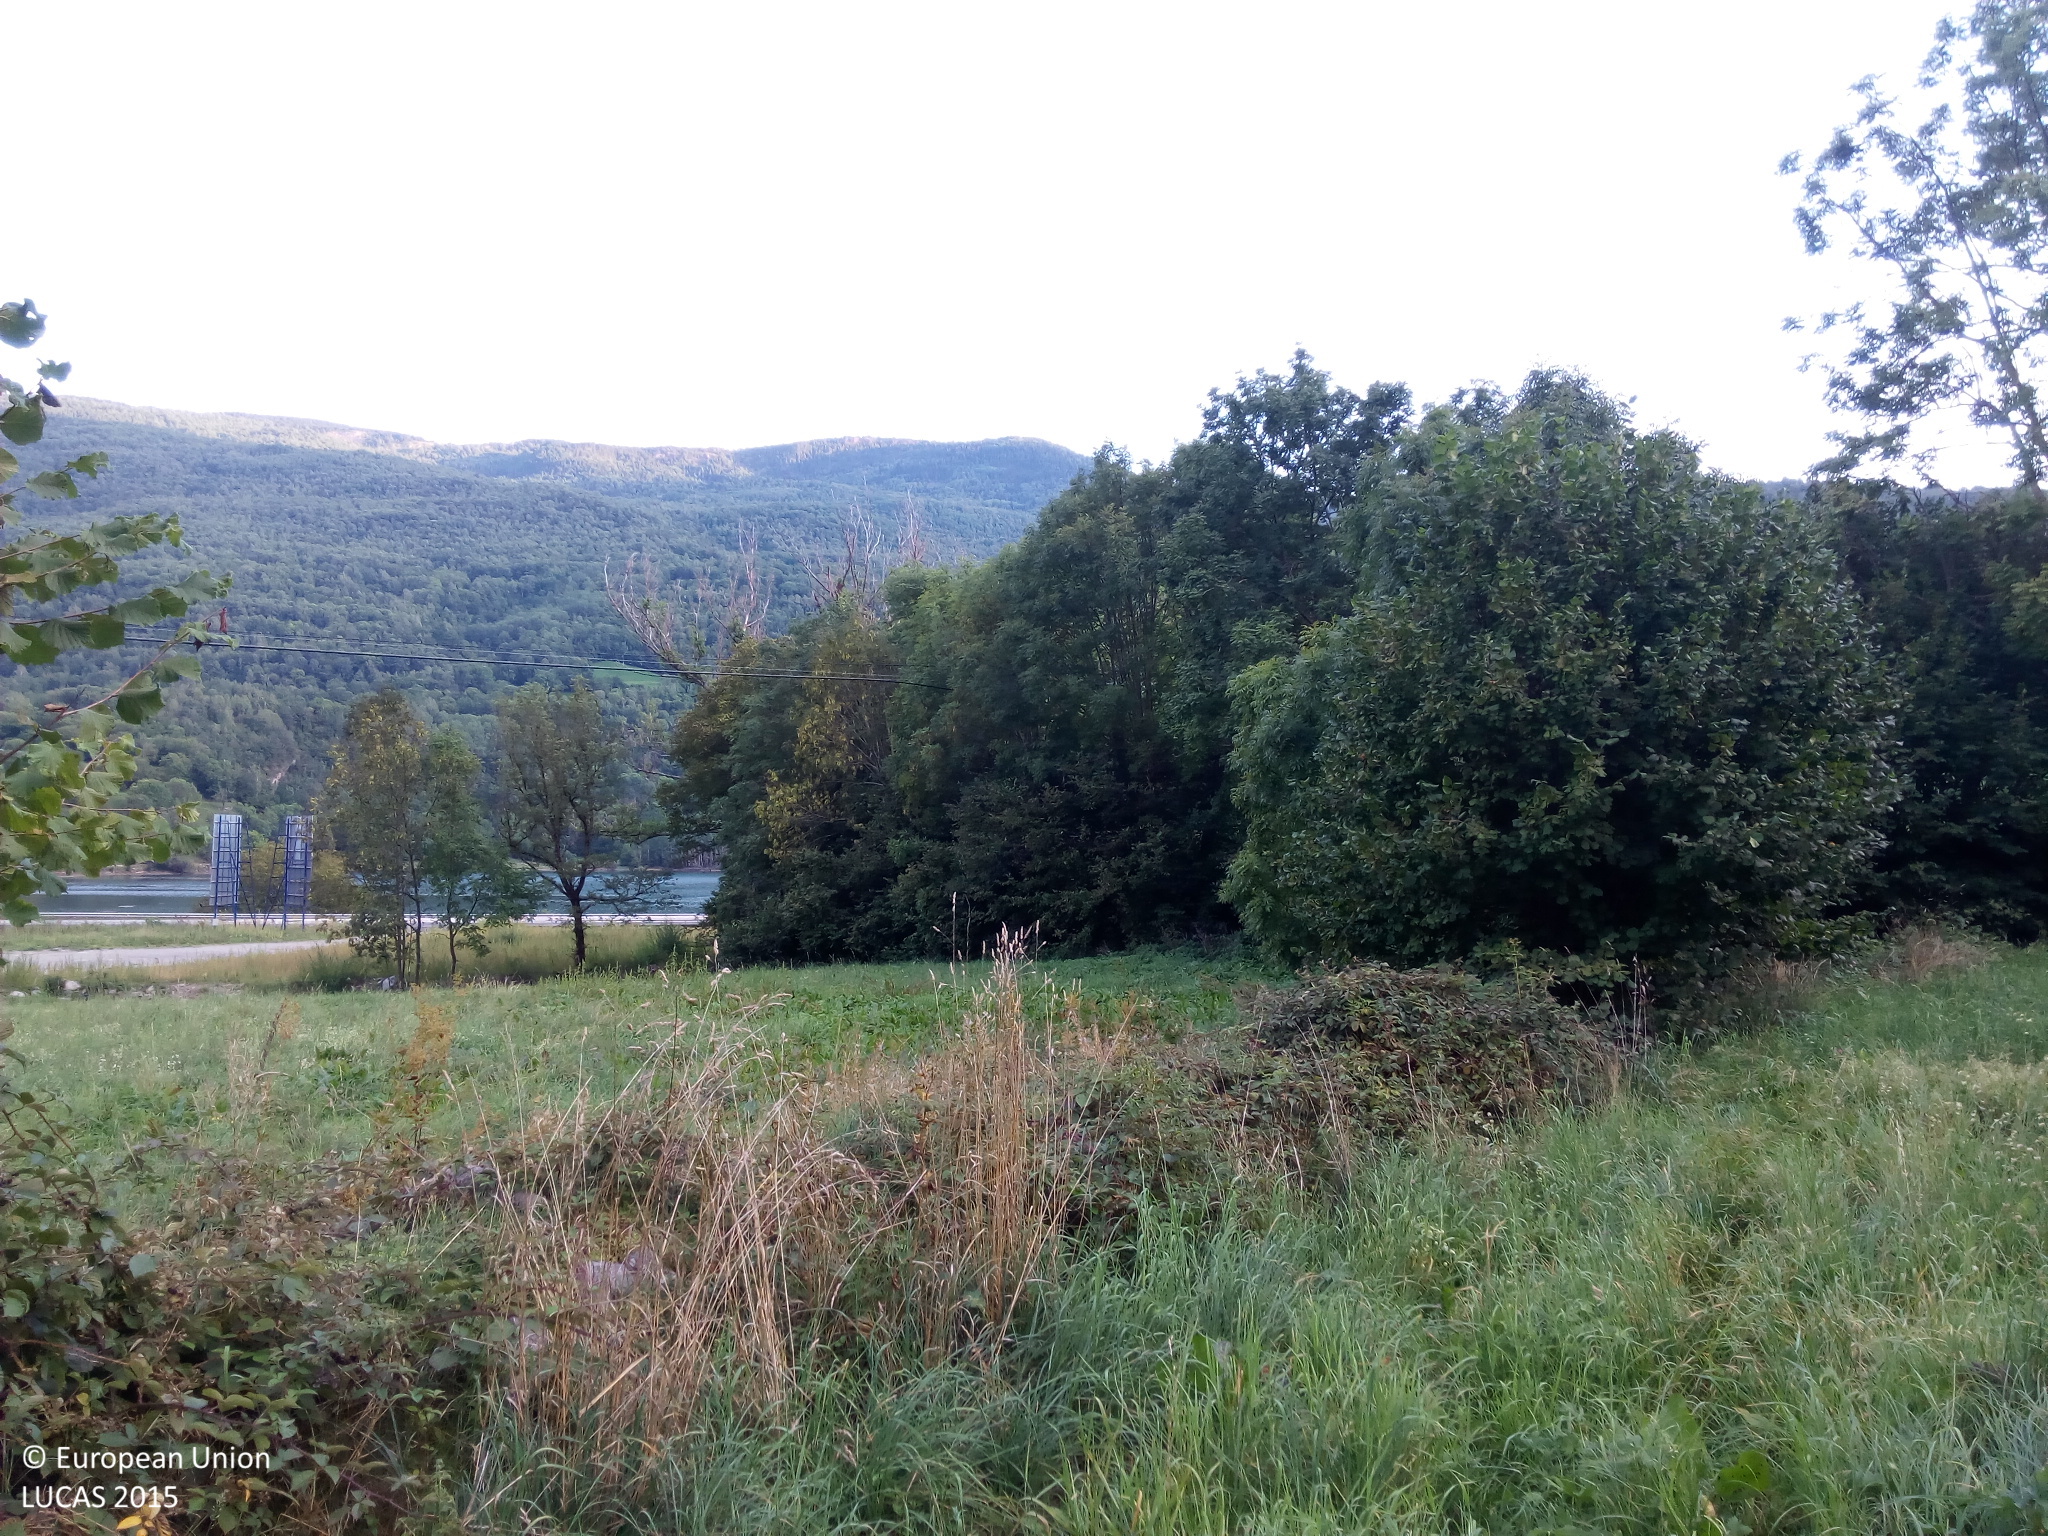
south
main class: Cropland
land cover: Apple fruit
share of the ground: > 75 %
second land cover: Spontaneously vegetated surfaces
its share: > 75 %
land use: Agriculture (excluding fallow land and kitchen gardens)
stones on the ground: < 10 %
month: September
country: ES
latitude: 42.5870
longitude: 0.4872
